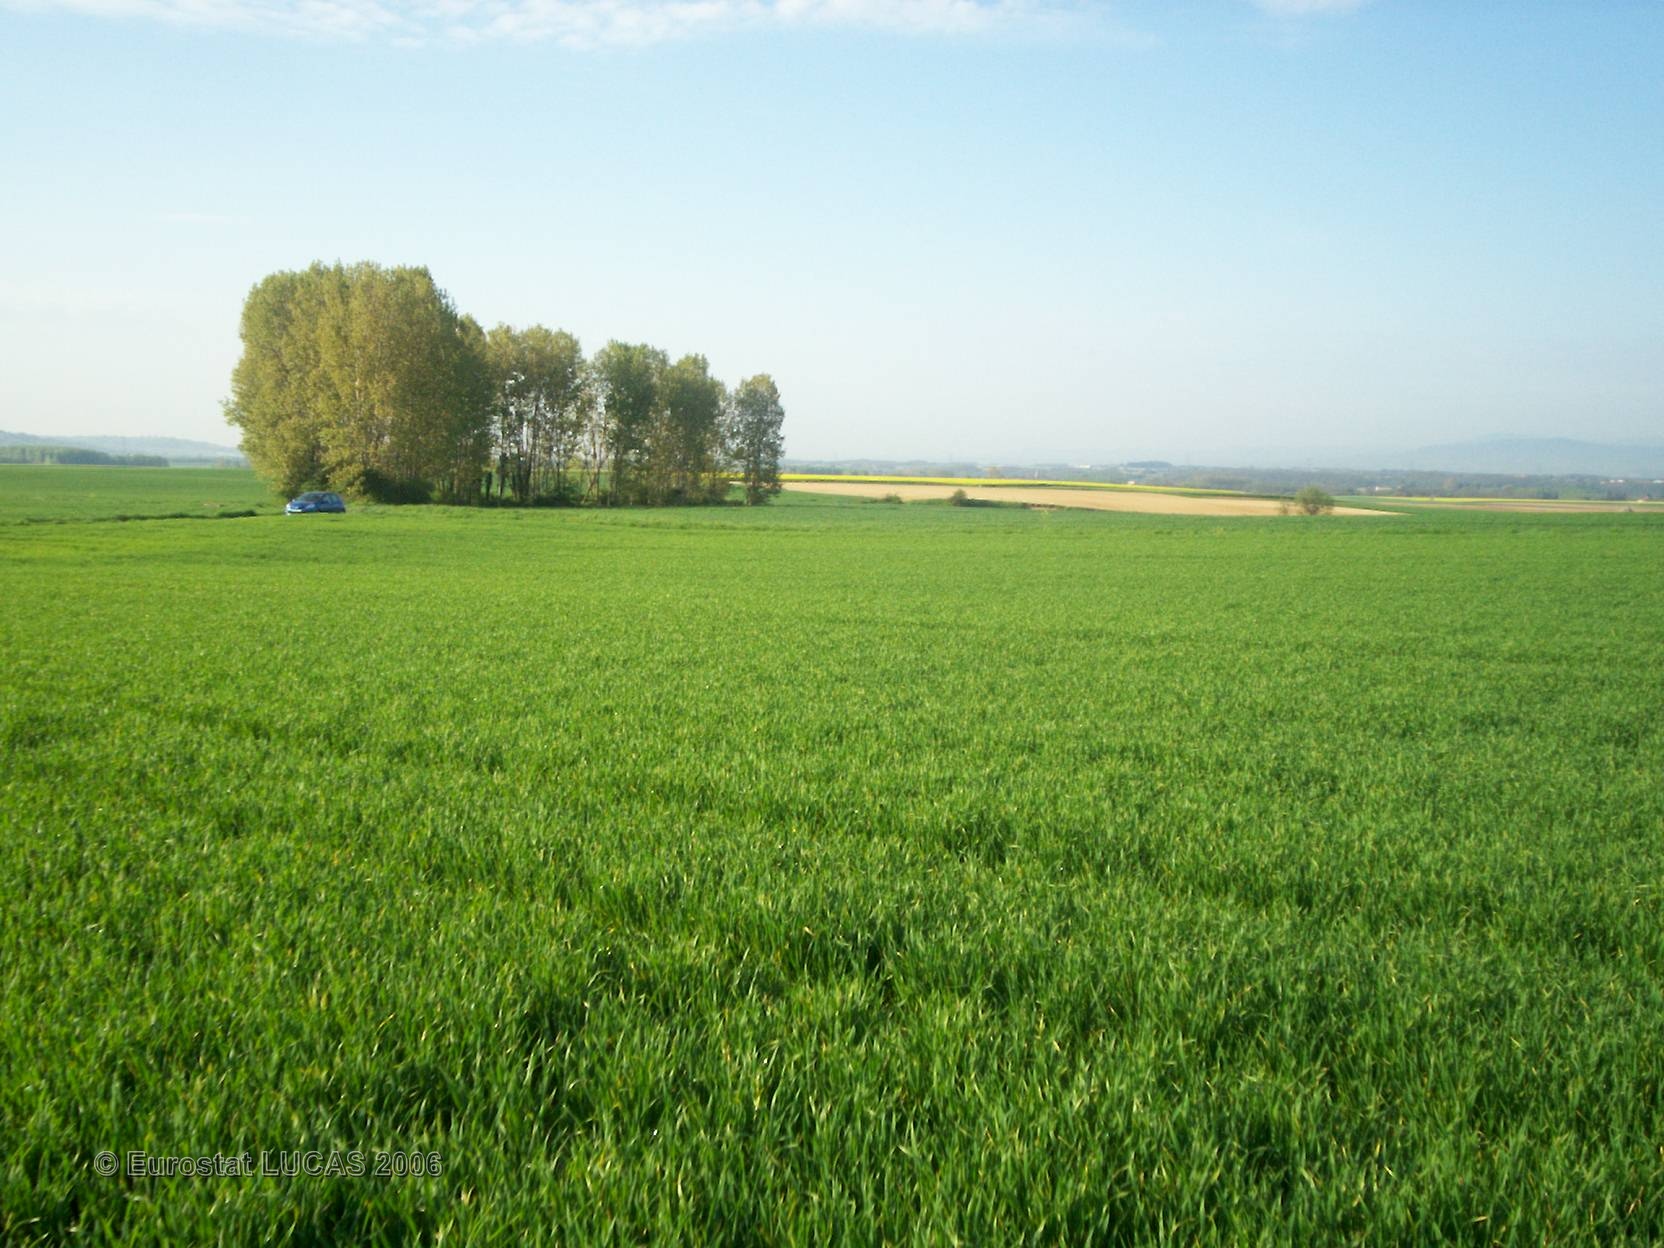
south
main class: Cropland
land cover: Common wheat
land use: Agriculture (excluding fallow land and kitchen gardens)
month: April
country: FR
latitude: 45.4510
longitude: 4.8513
